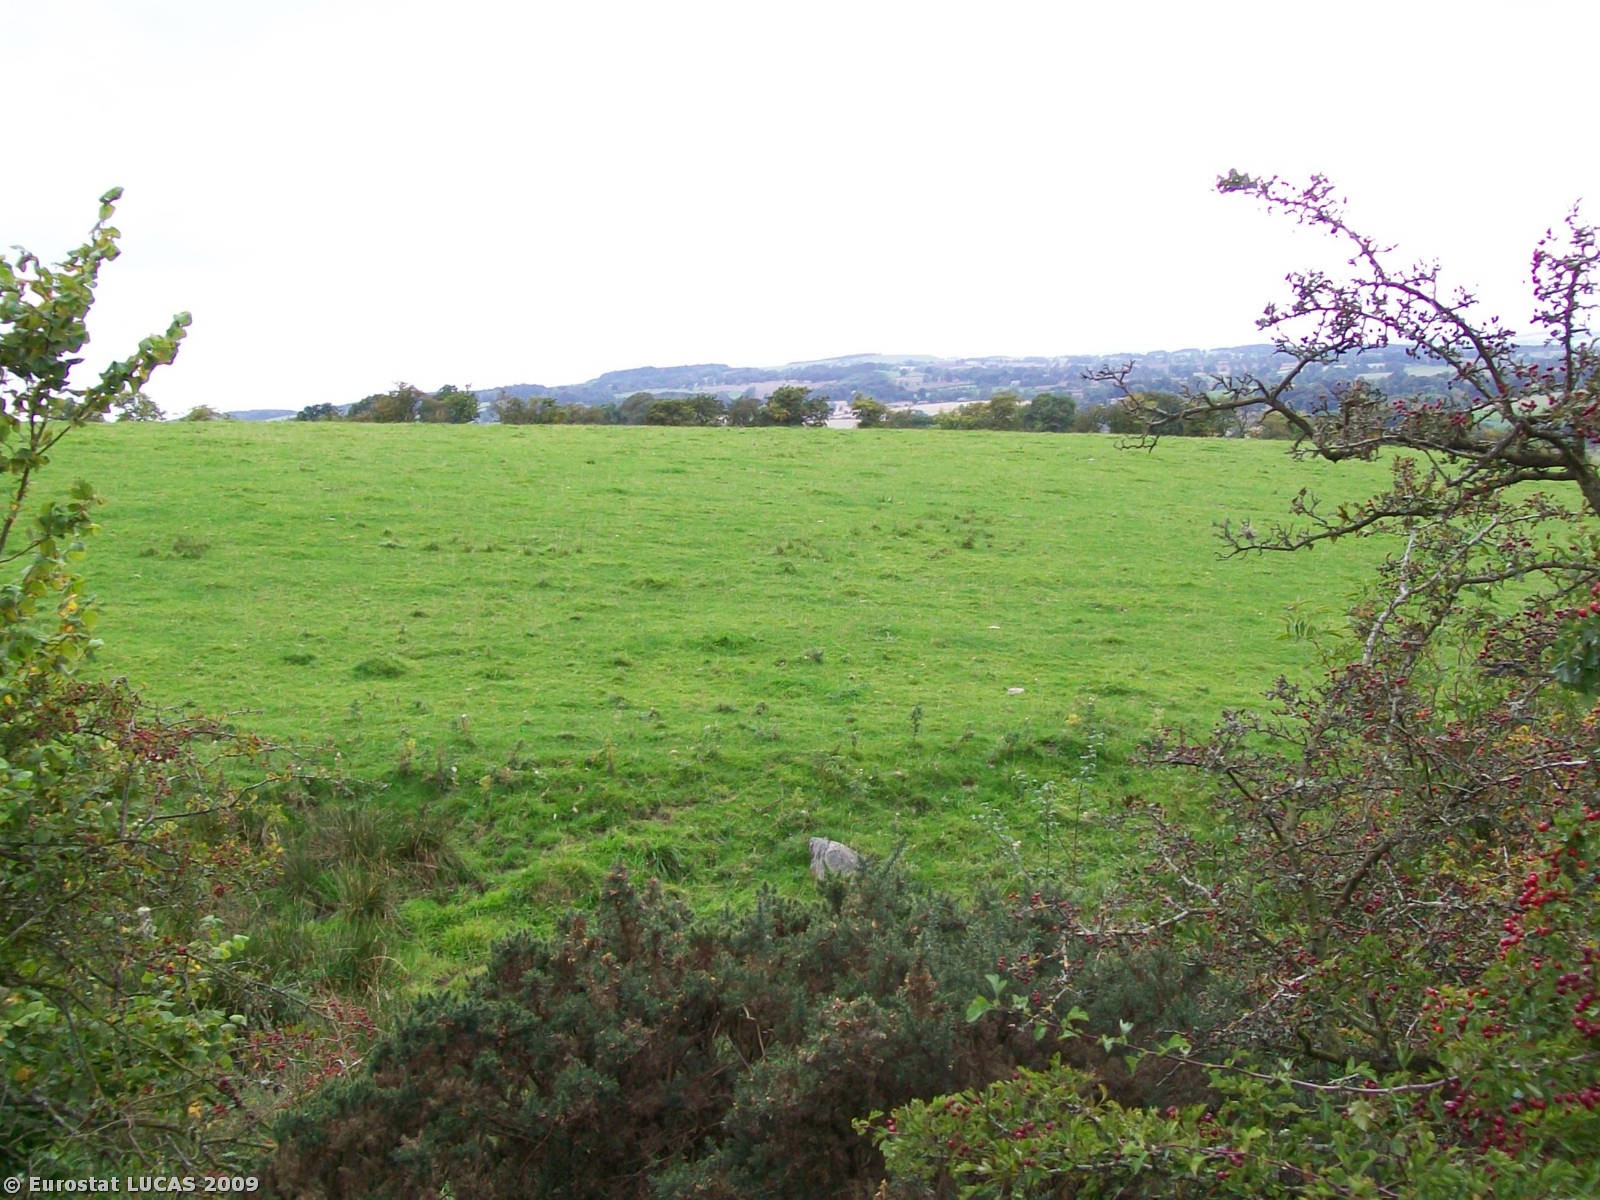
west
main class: Woodland
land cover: Broadleaved woodland
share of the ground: > 75 %
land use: Agriculture (excluding fallow land and kitchen gardens)
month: September
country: GB
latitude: 55.0315
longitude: -2.0870
